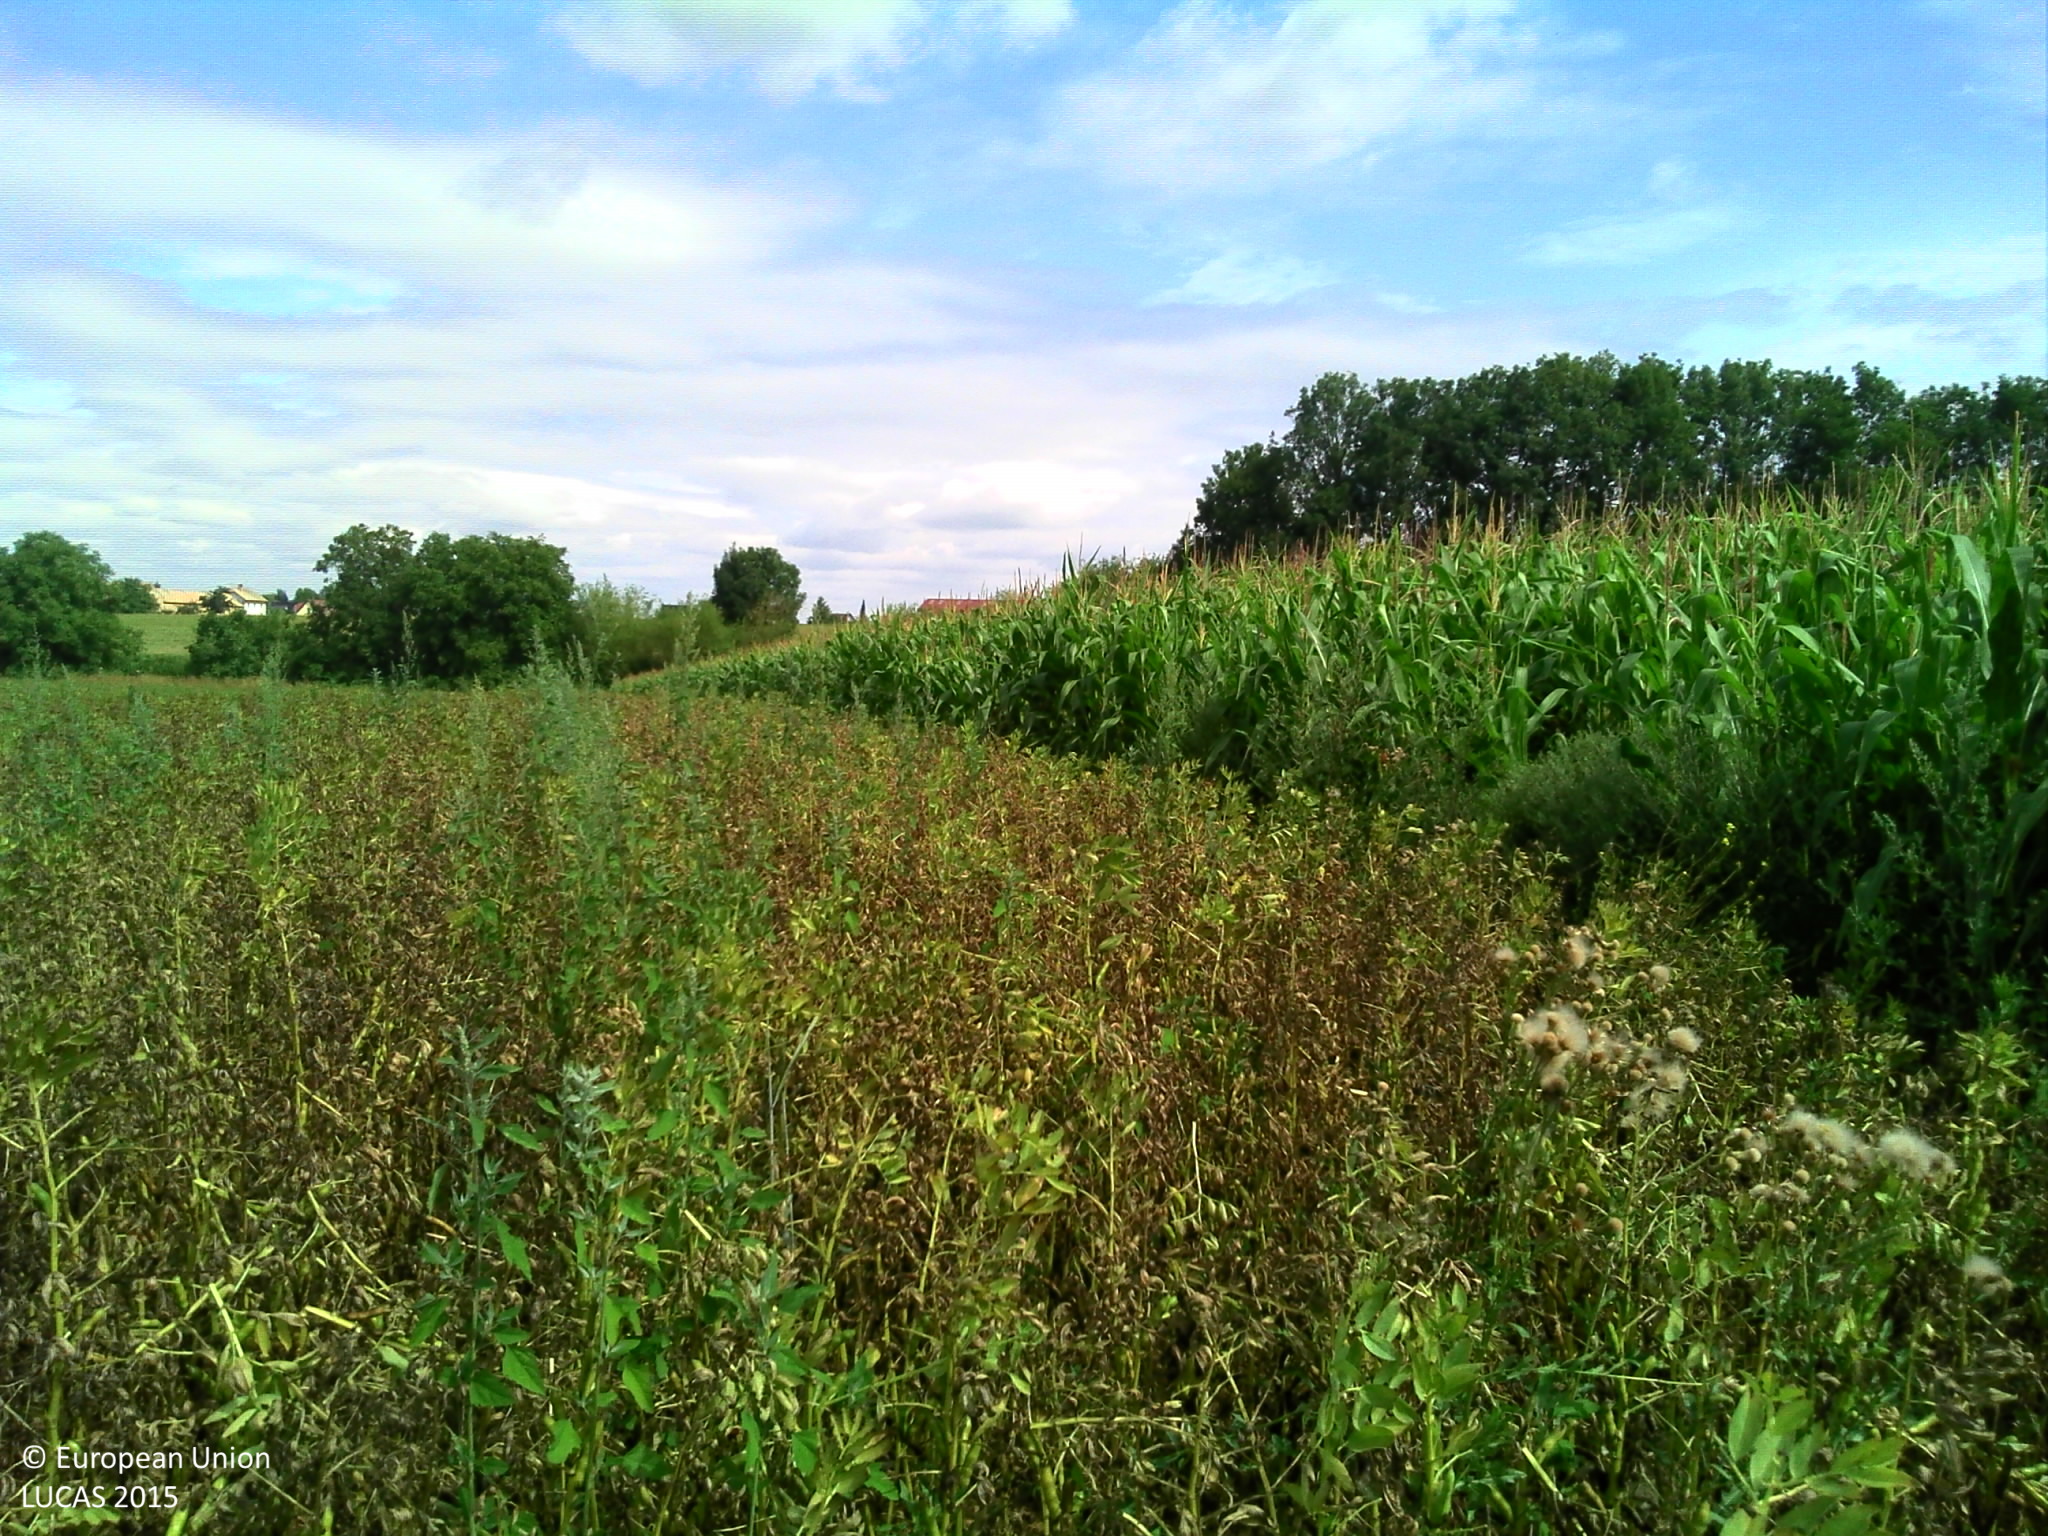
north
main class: Cropland
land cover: Soya
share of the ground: > 75 %
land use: Agriculture (excluding fallow land and kitchen gardens)
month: July
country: FR
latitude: 48.6115
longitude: 7.6001
